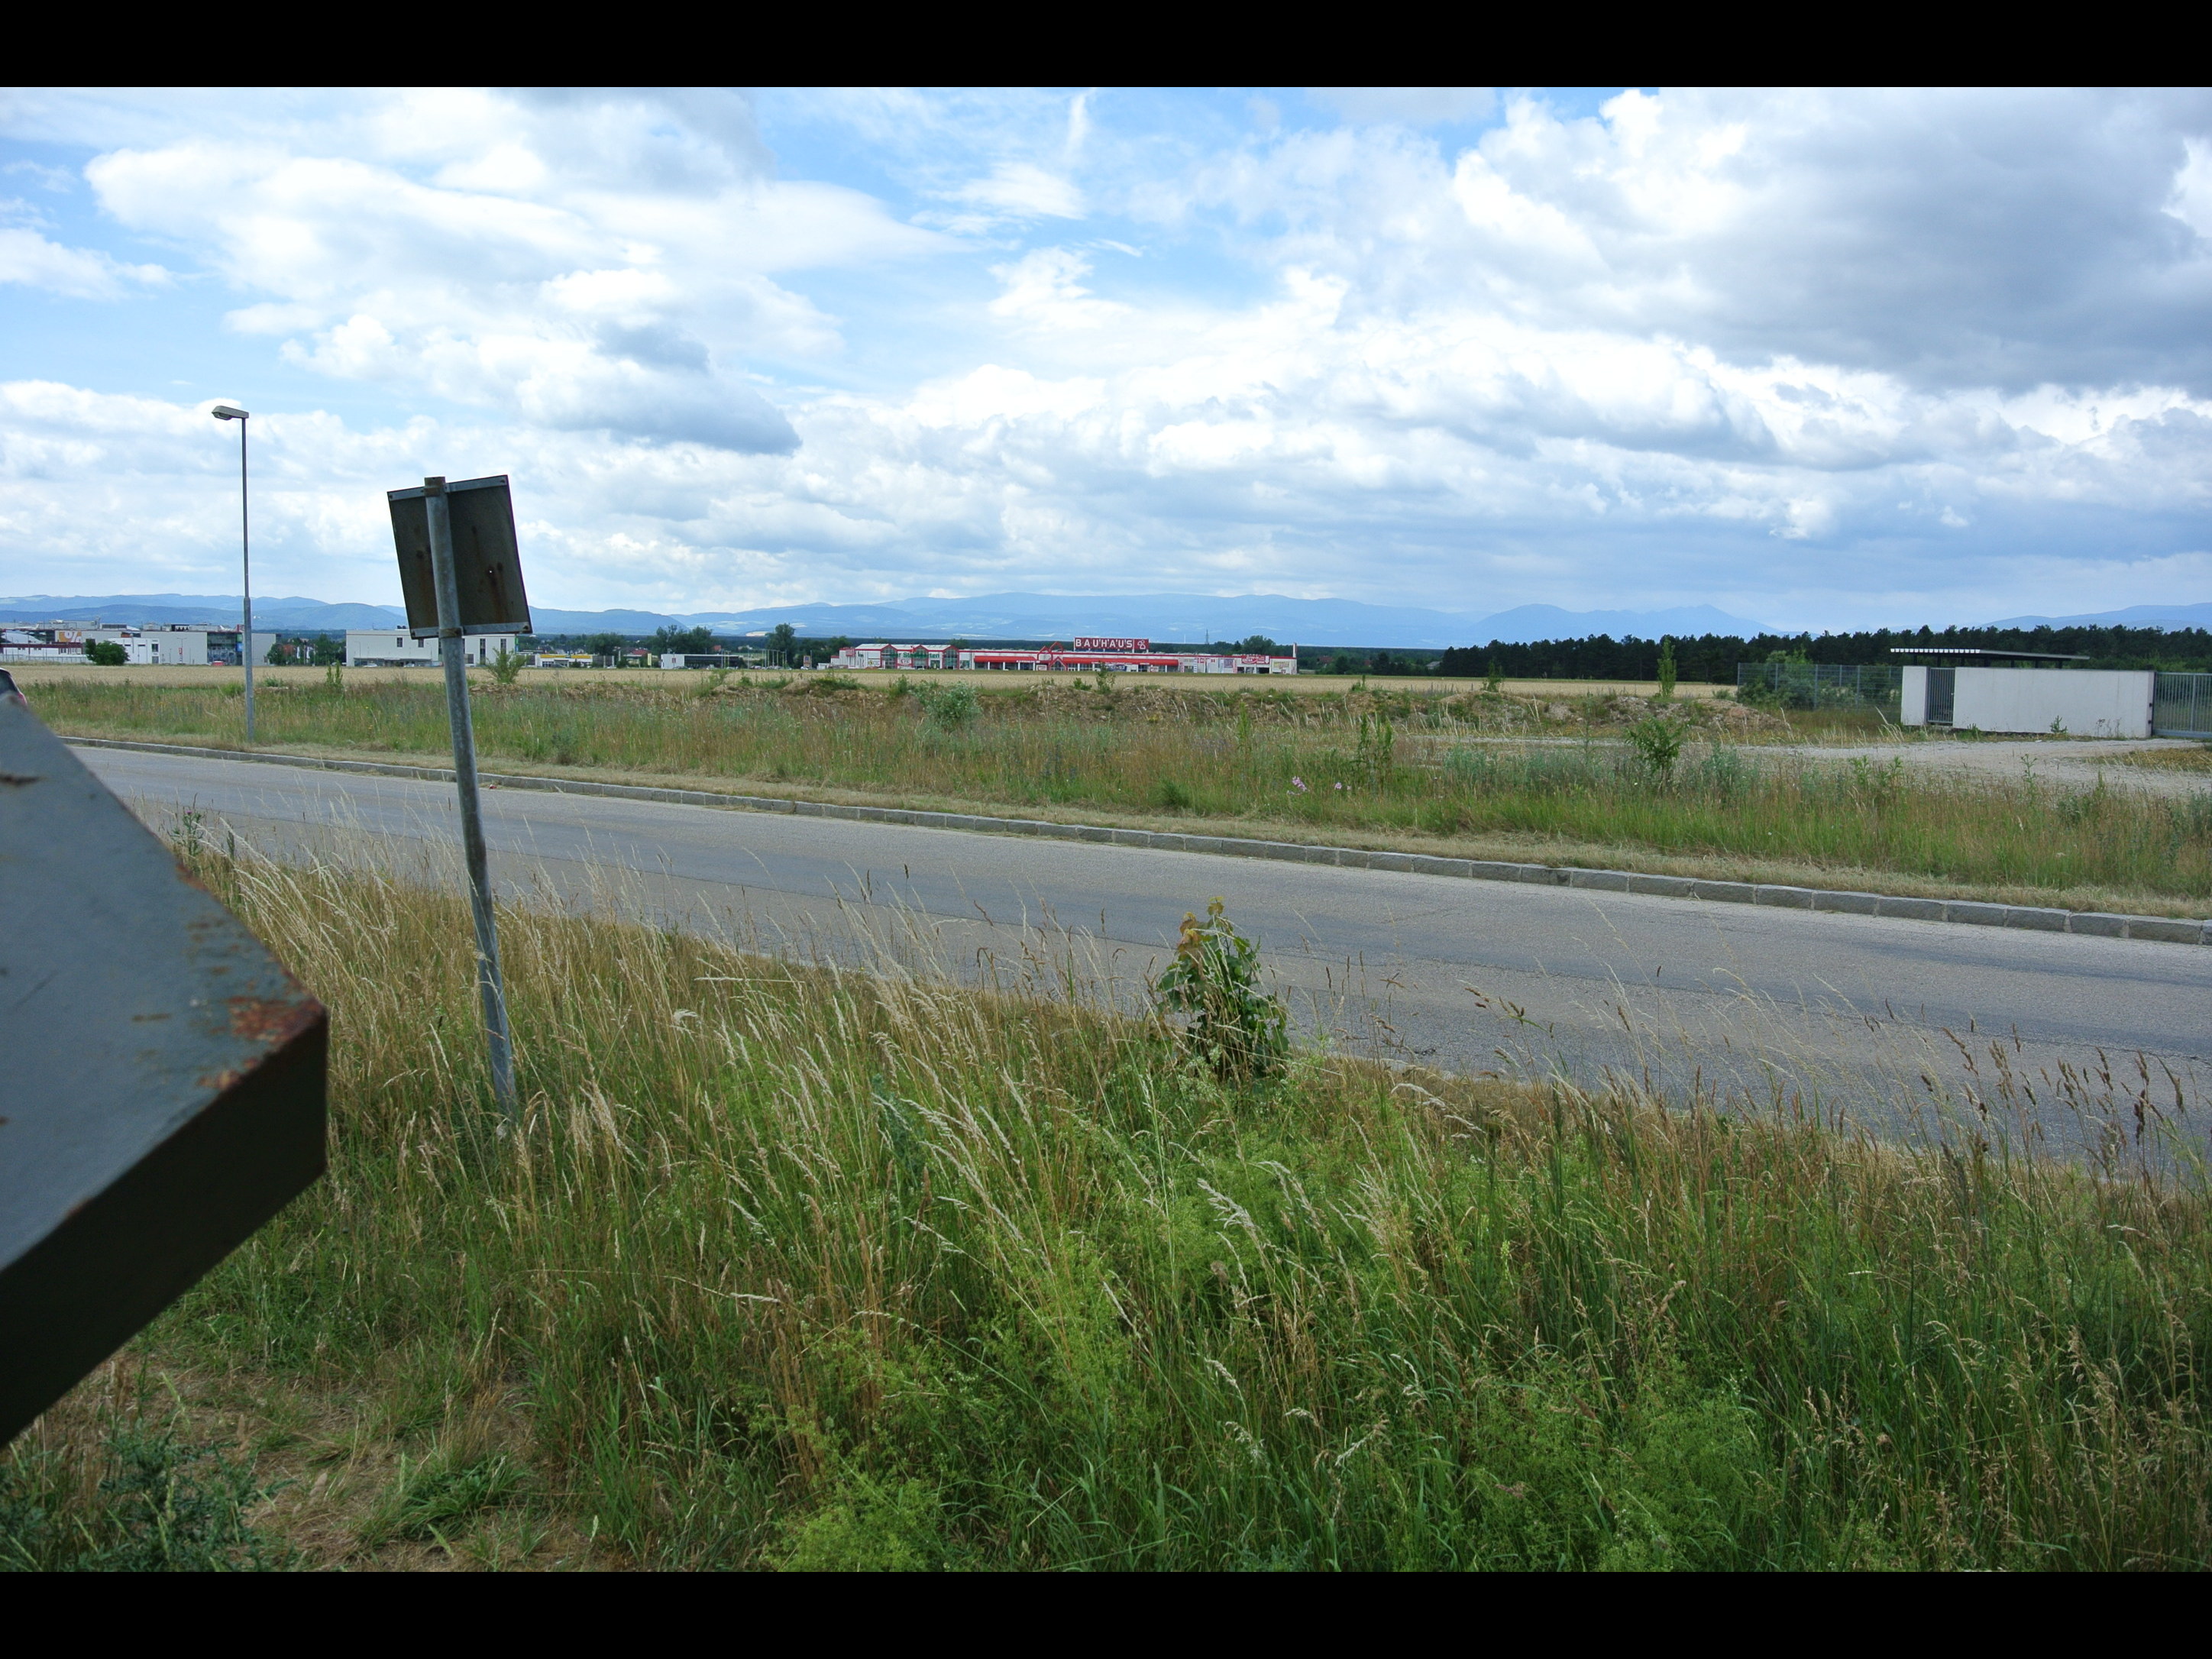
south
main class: Grassland
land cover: Grassland without tree/shrub cover
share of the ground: > 75 %
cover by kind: herbaceous plants 100 %
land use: Air transport
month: June
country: AT
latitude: 47.8316
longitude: 16.2157
